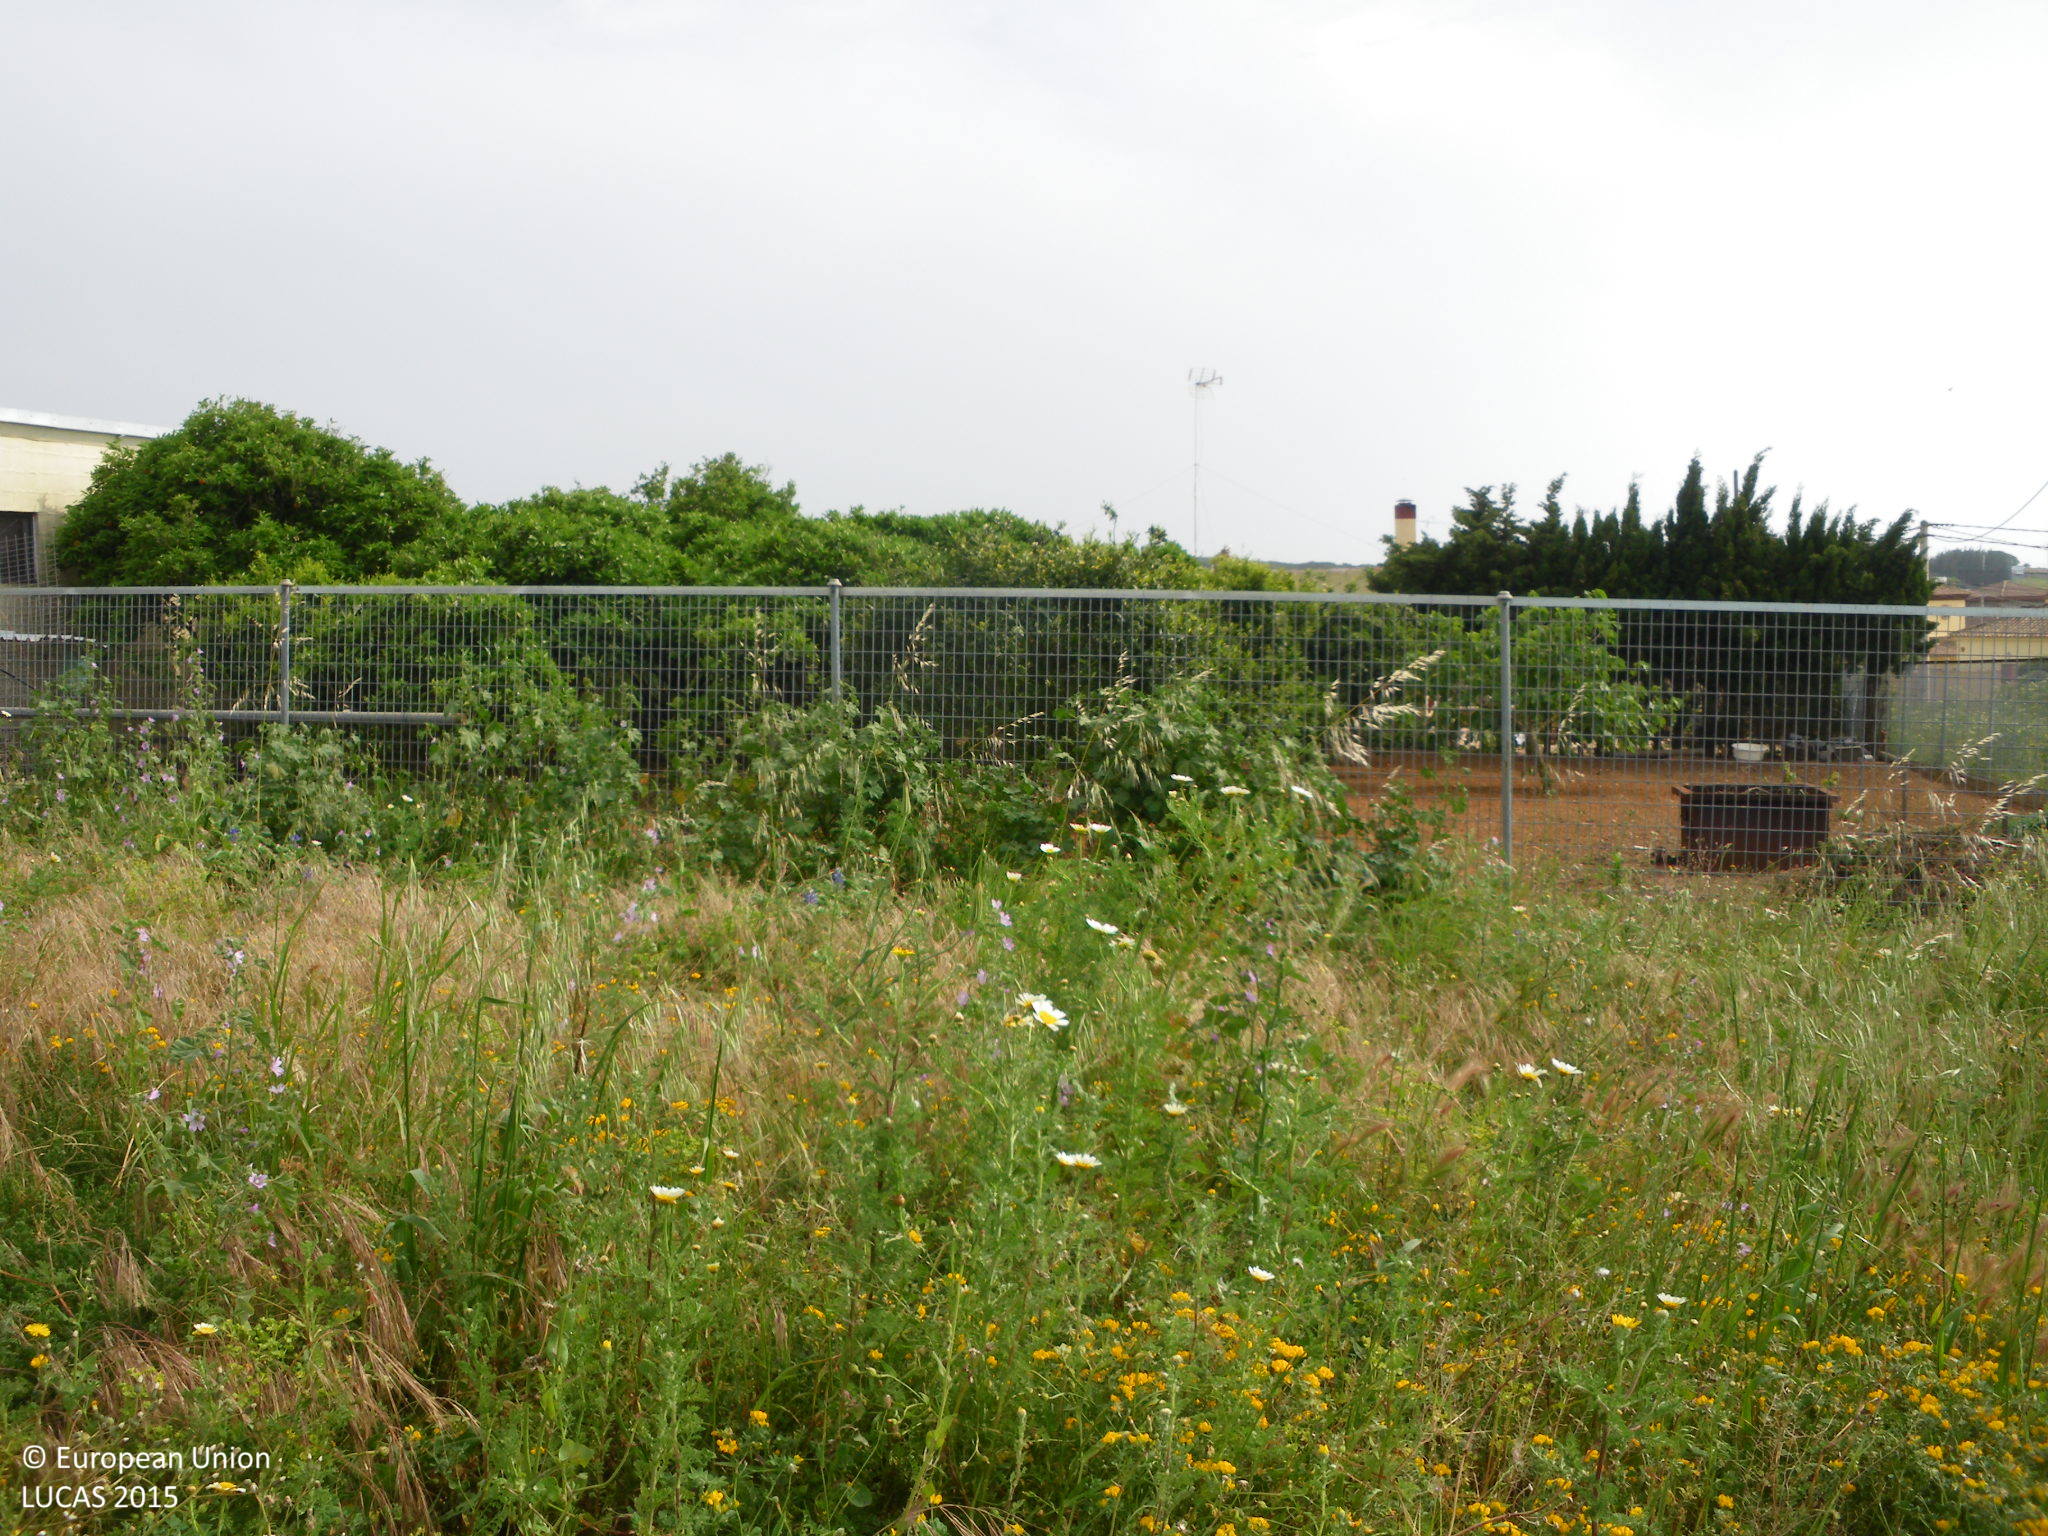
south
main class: Grassland
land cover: Grassland with sparse tree/shrub cover
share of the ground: > 75 %
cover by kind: herbaceous plants 90 %, broadleaved forest trees 5 %, shrubs 5 %
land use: Abandoned areas
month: April
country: ES
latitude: 36.3959
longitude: -6.1396
